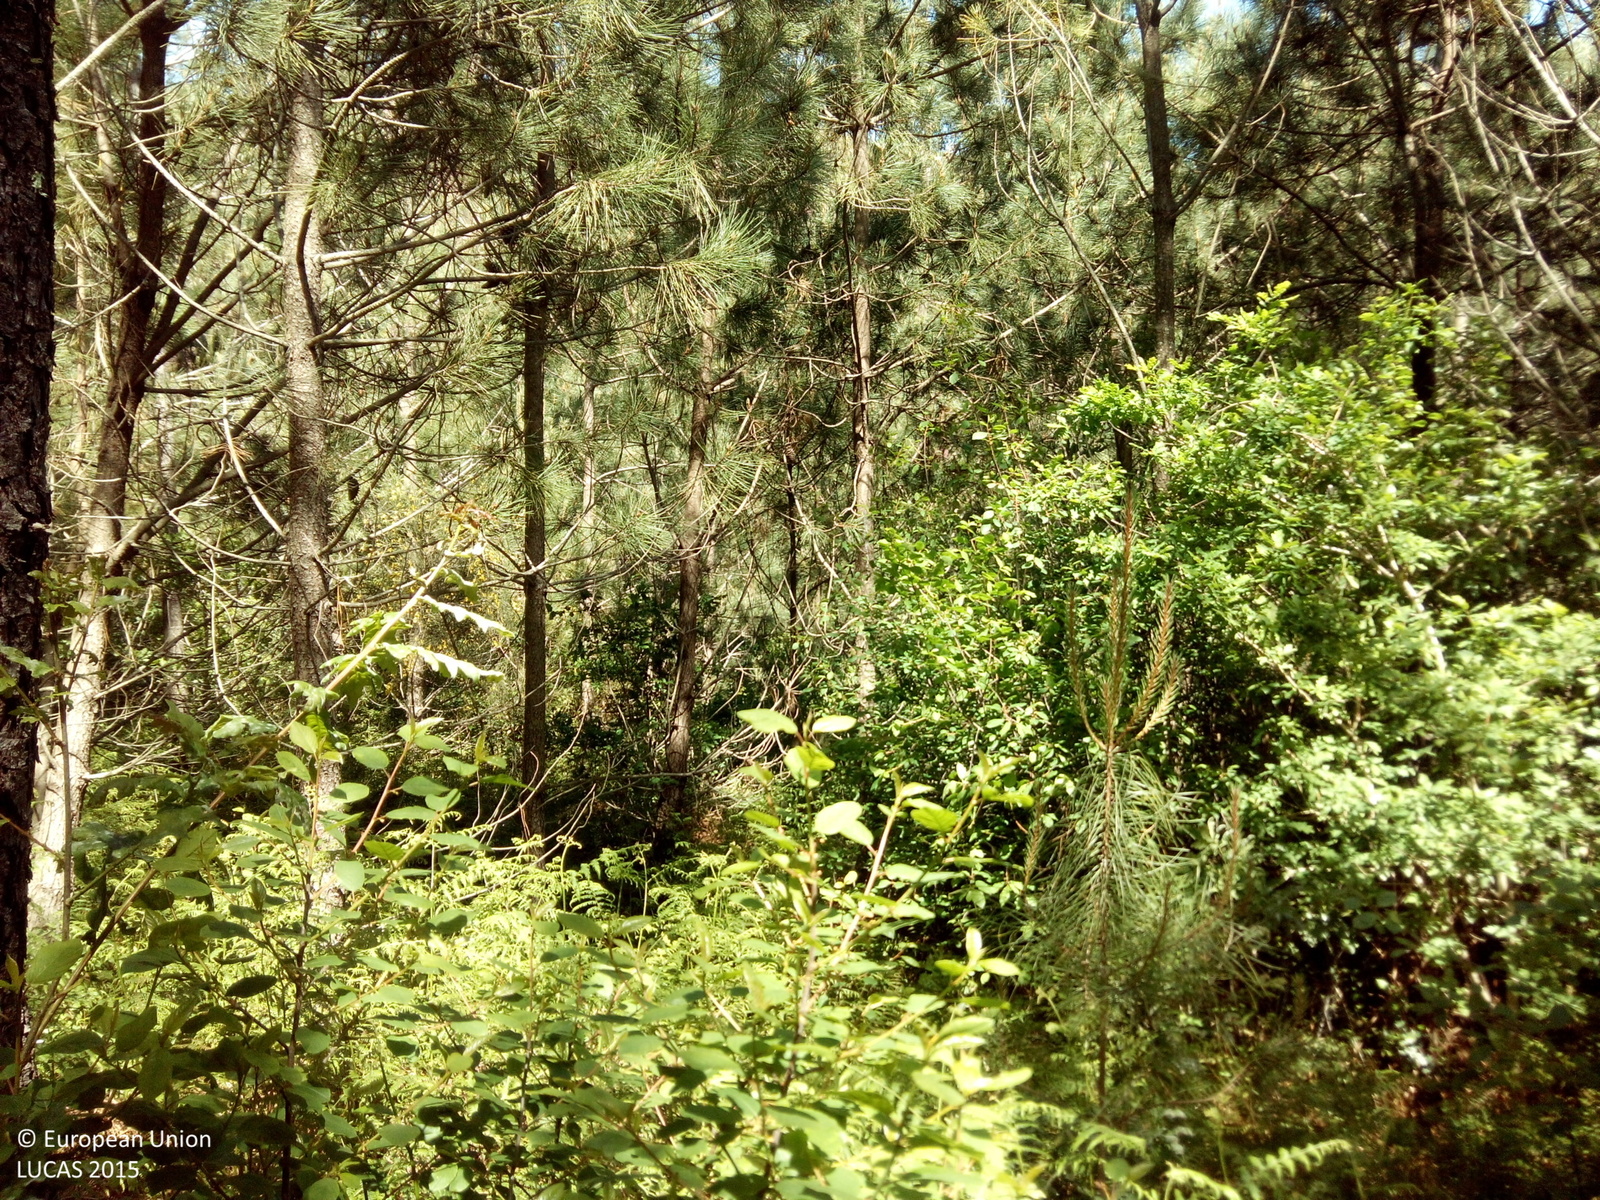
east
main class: Woodland
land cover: Pine dominated coniferous woodland
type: hemiboreal forest and nemoral coniferous forest and mixed broadleaved-coniferous forest
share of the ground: > 75 %
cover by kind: coniferous forest trees 75 %, shrubs 25 %
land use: Forestry
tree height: > 5 m
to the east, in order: Pine dominated coniferous woodland; Pine dominated mixed woodland; Paved roads, cycling and walking lanes; Ditches and canals; Artificial constructions; Shrubland with sparse tree cover; Broadleaved woodland
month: May
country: ES
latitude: 42.6690
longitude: -8.9918
